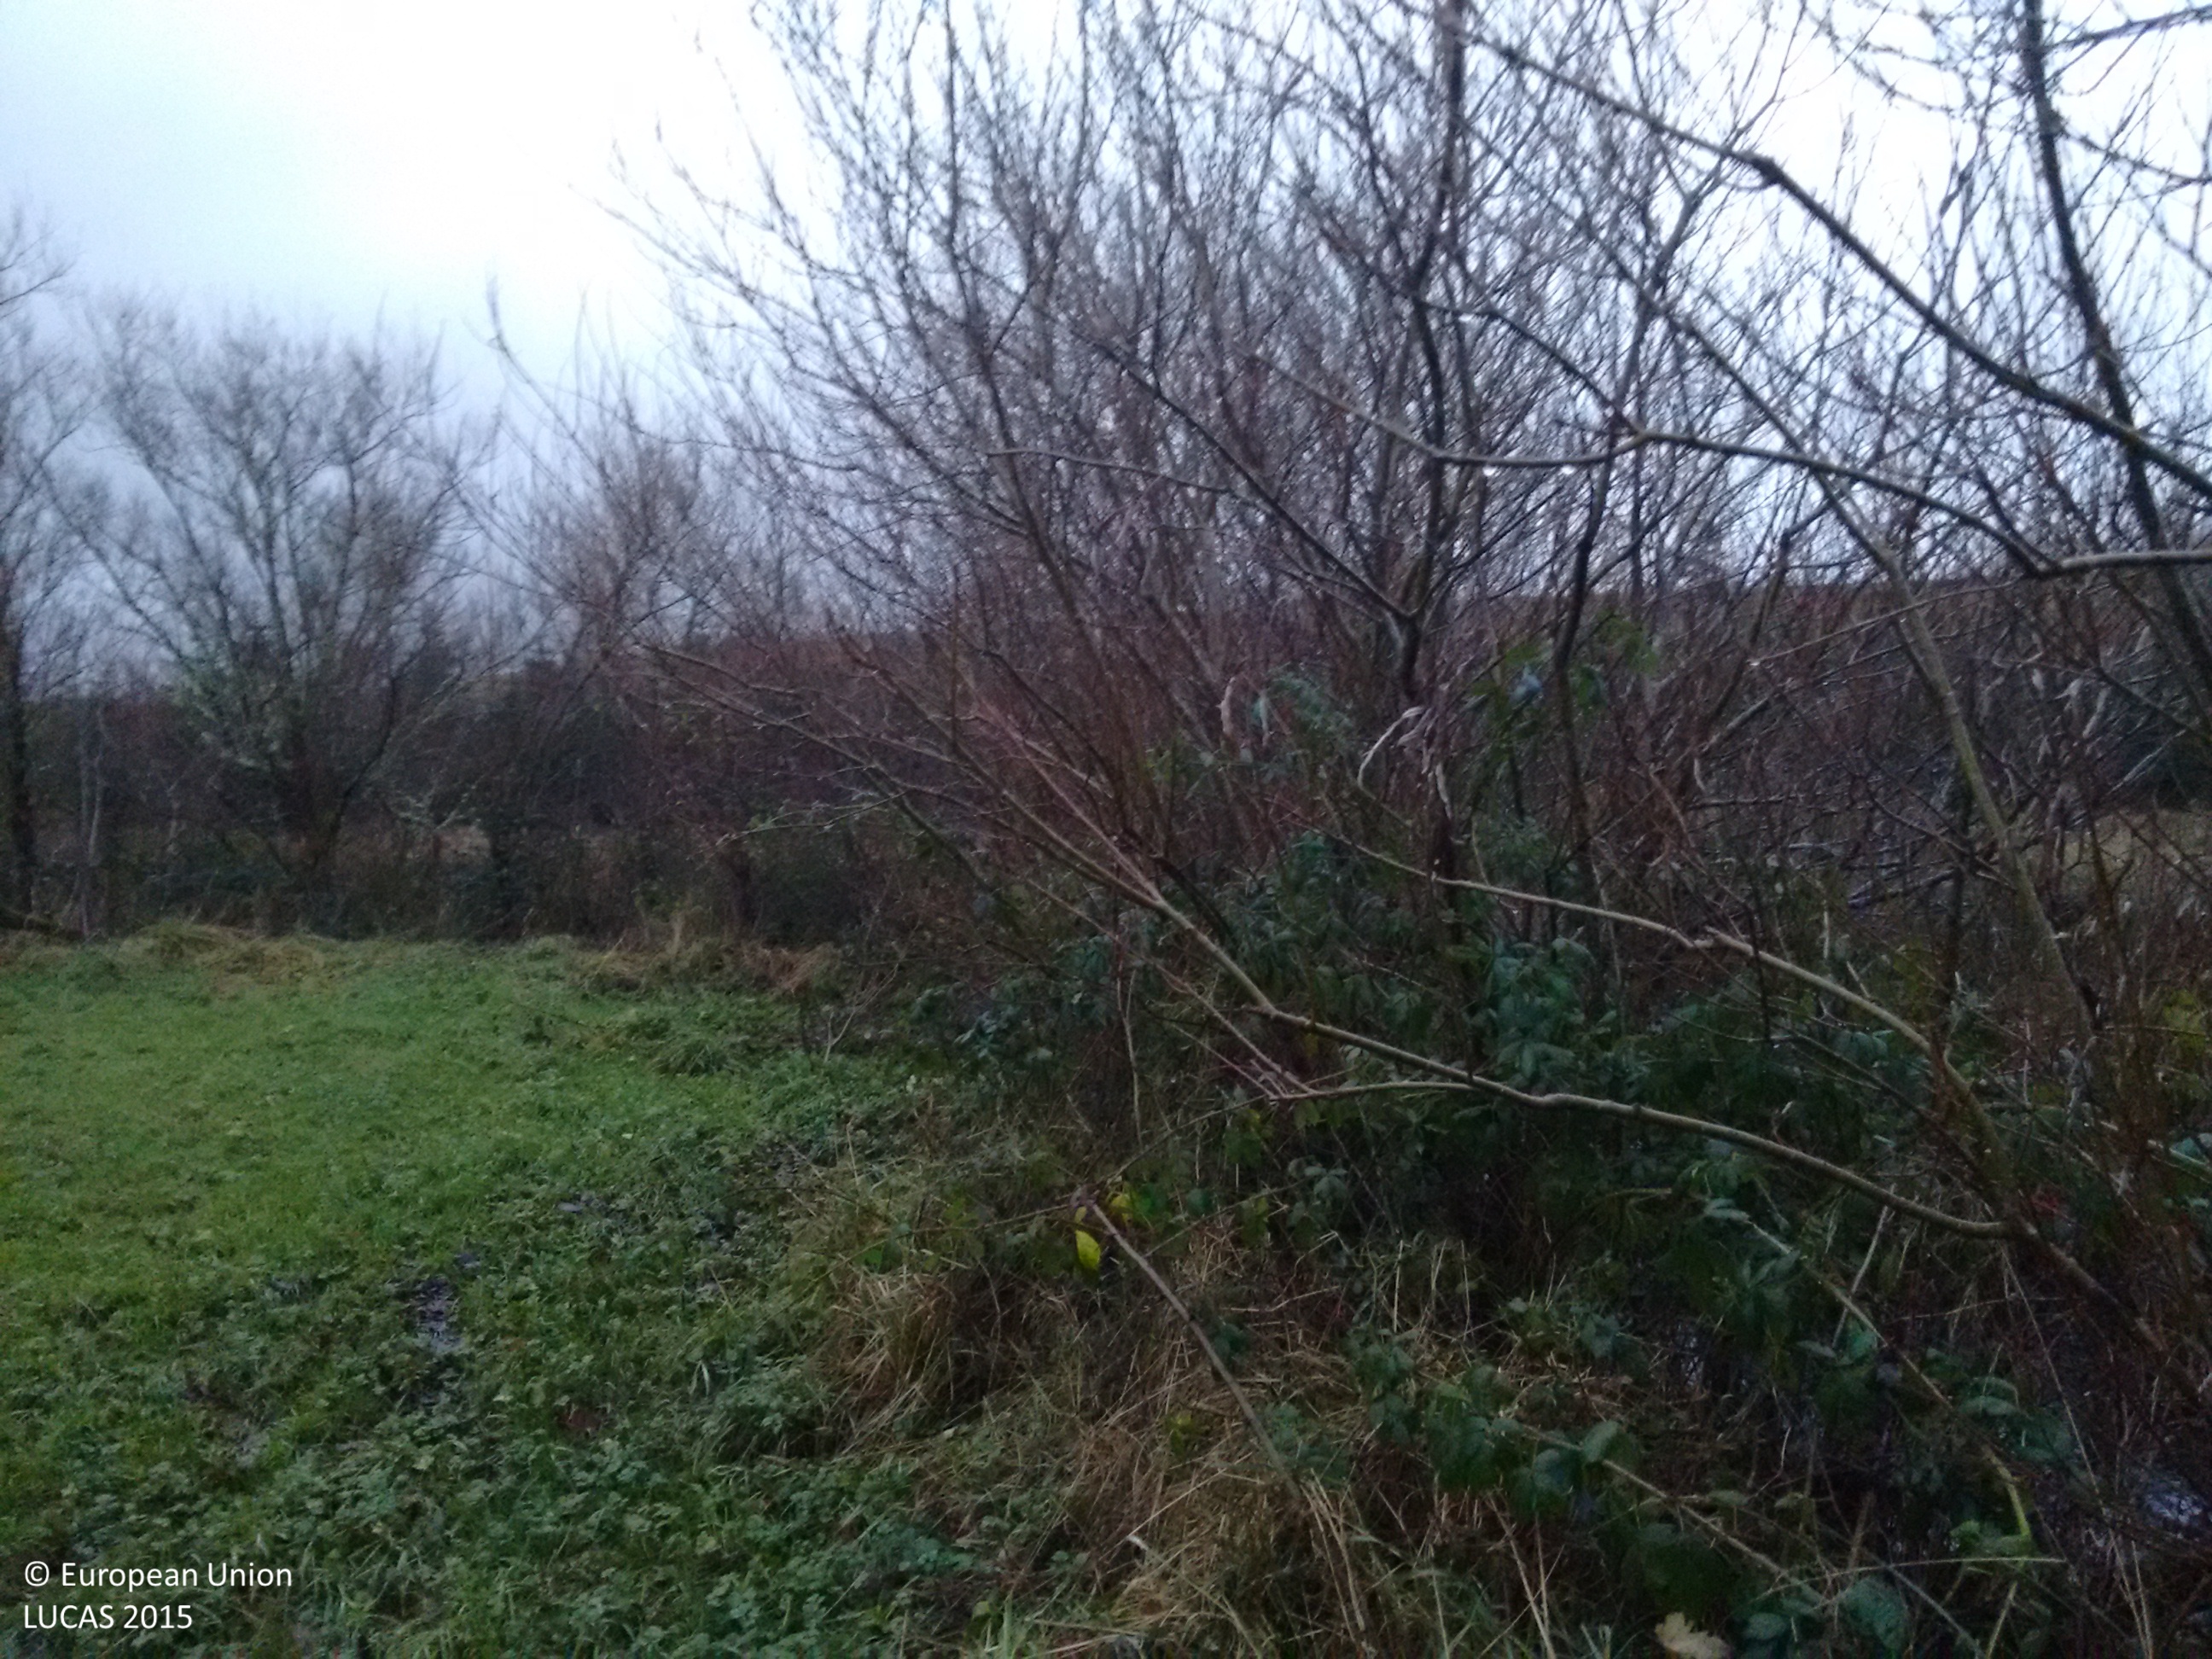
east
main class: Woodland
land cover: Spruce dominated coniferous woodland
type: exotic forest
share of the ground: > 75 %
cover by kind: coniferous forest trees 100 %
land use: Forestry
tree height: > 5 m
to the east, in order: Spruce dominated coniferous woodland; Fences; Shrubland without tree cover
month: December
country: IE
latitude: 54.2223
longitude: -7.9480
